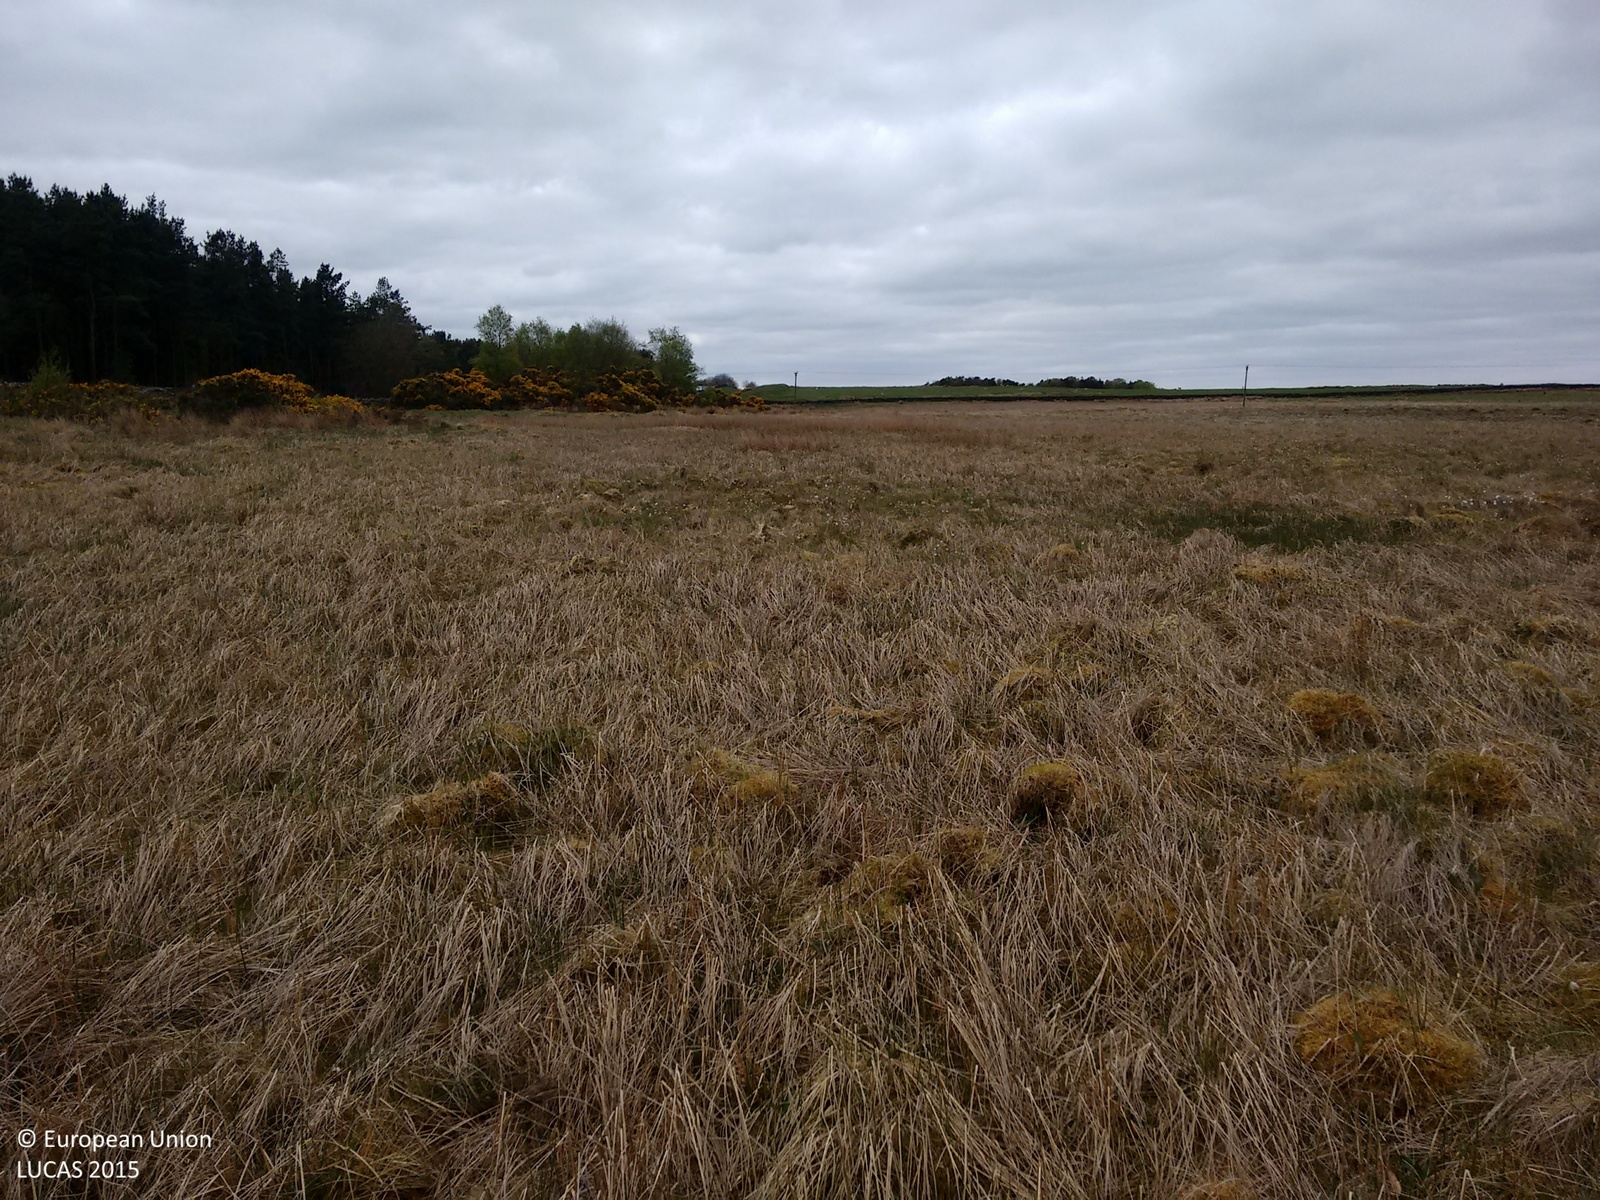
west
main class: Grassland
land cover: Grassland without tree/shrub cover
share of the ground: > 75 %
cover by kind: herbaceous plants 100 %
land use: Agriculture (excluding fallow land and kitchen gardens)
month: May
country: GB
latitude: 55.0168
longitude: -2.0508
